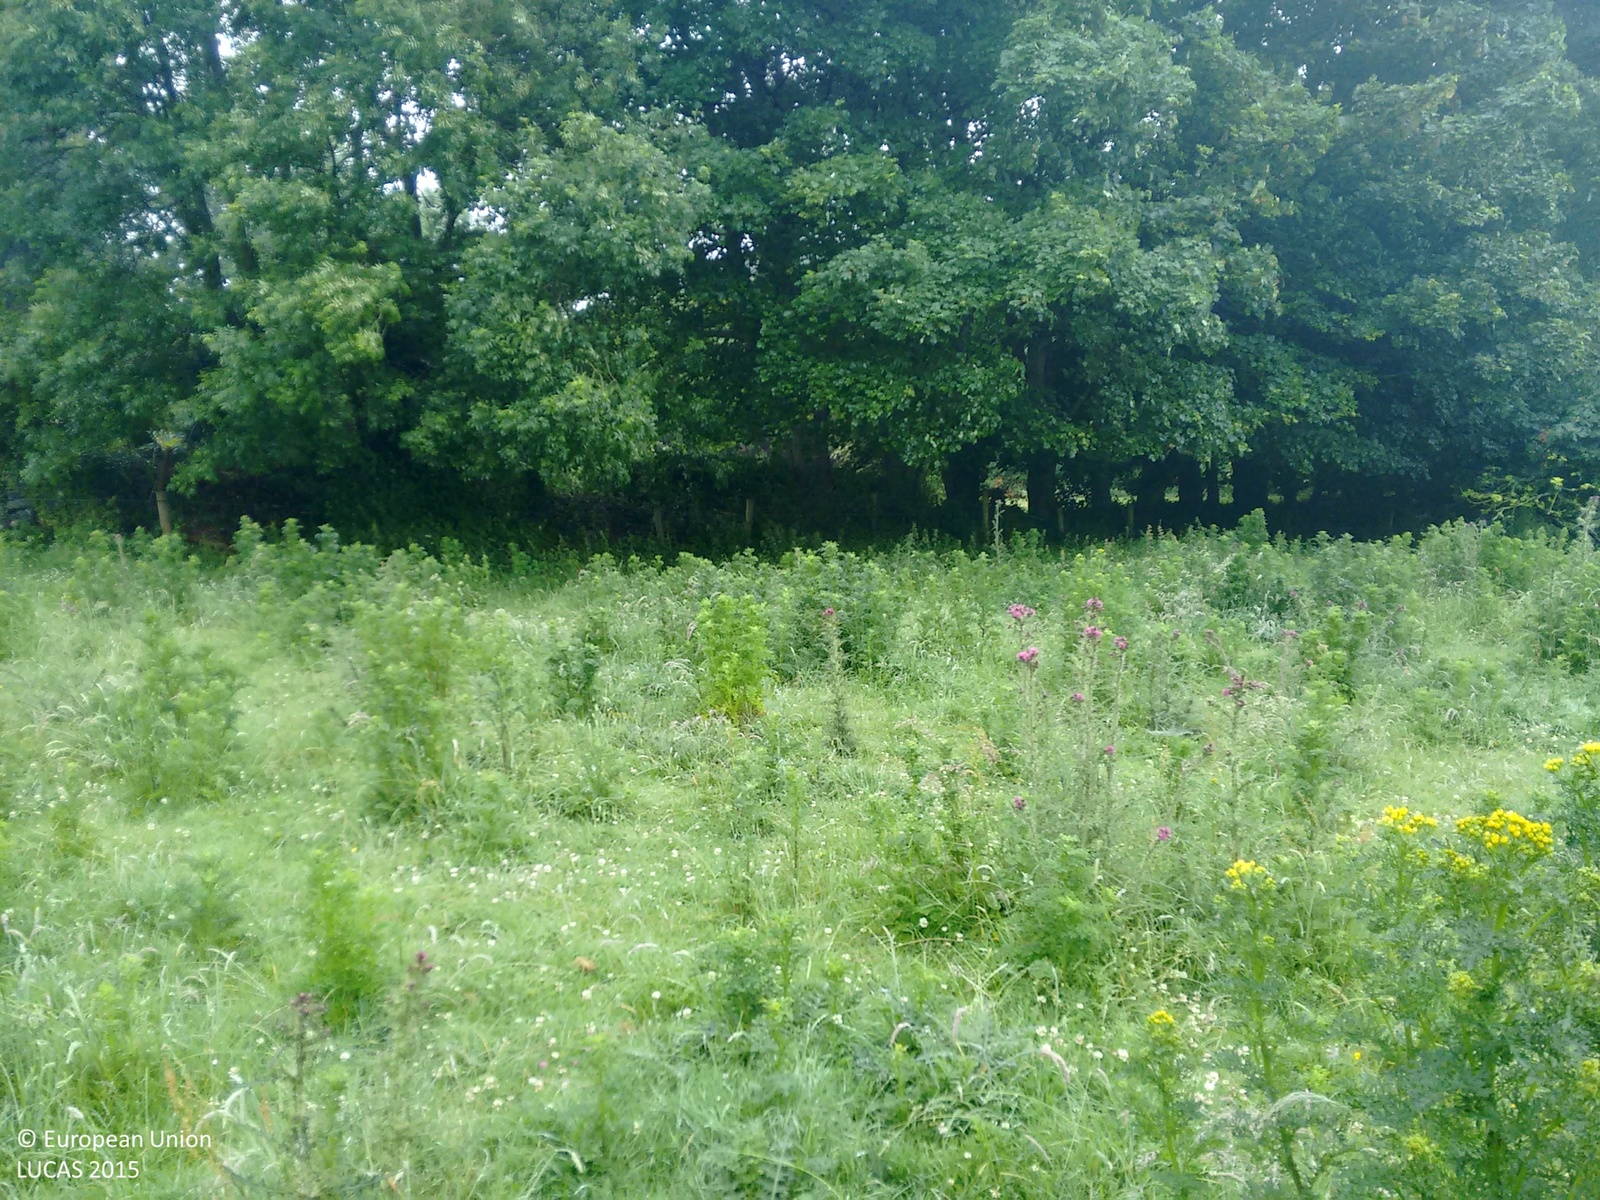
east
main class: Grassland
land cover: Grassland without tree/shrub cover
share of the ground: > 75 %
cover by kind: herbaceous plants 100 %
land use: Agriculture (excluding fallow land and kitchen gardens)
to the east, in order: Grassland without tree/shrub cover; Artificial constructions in urban areas; Grassland without tree/shrub cover; Electric lines; Grassland without tree/shrub cover; Fences; Abandoned hedges; Grass margins; Tracks; Broadleaved woodland; Artificial constructions in urban areas
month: June
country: IE
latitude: 52.3823
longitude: -7.2974
